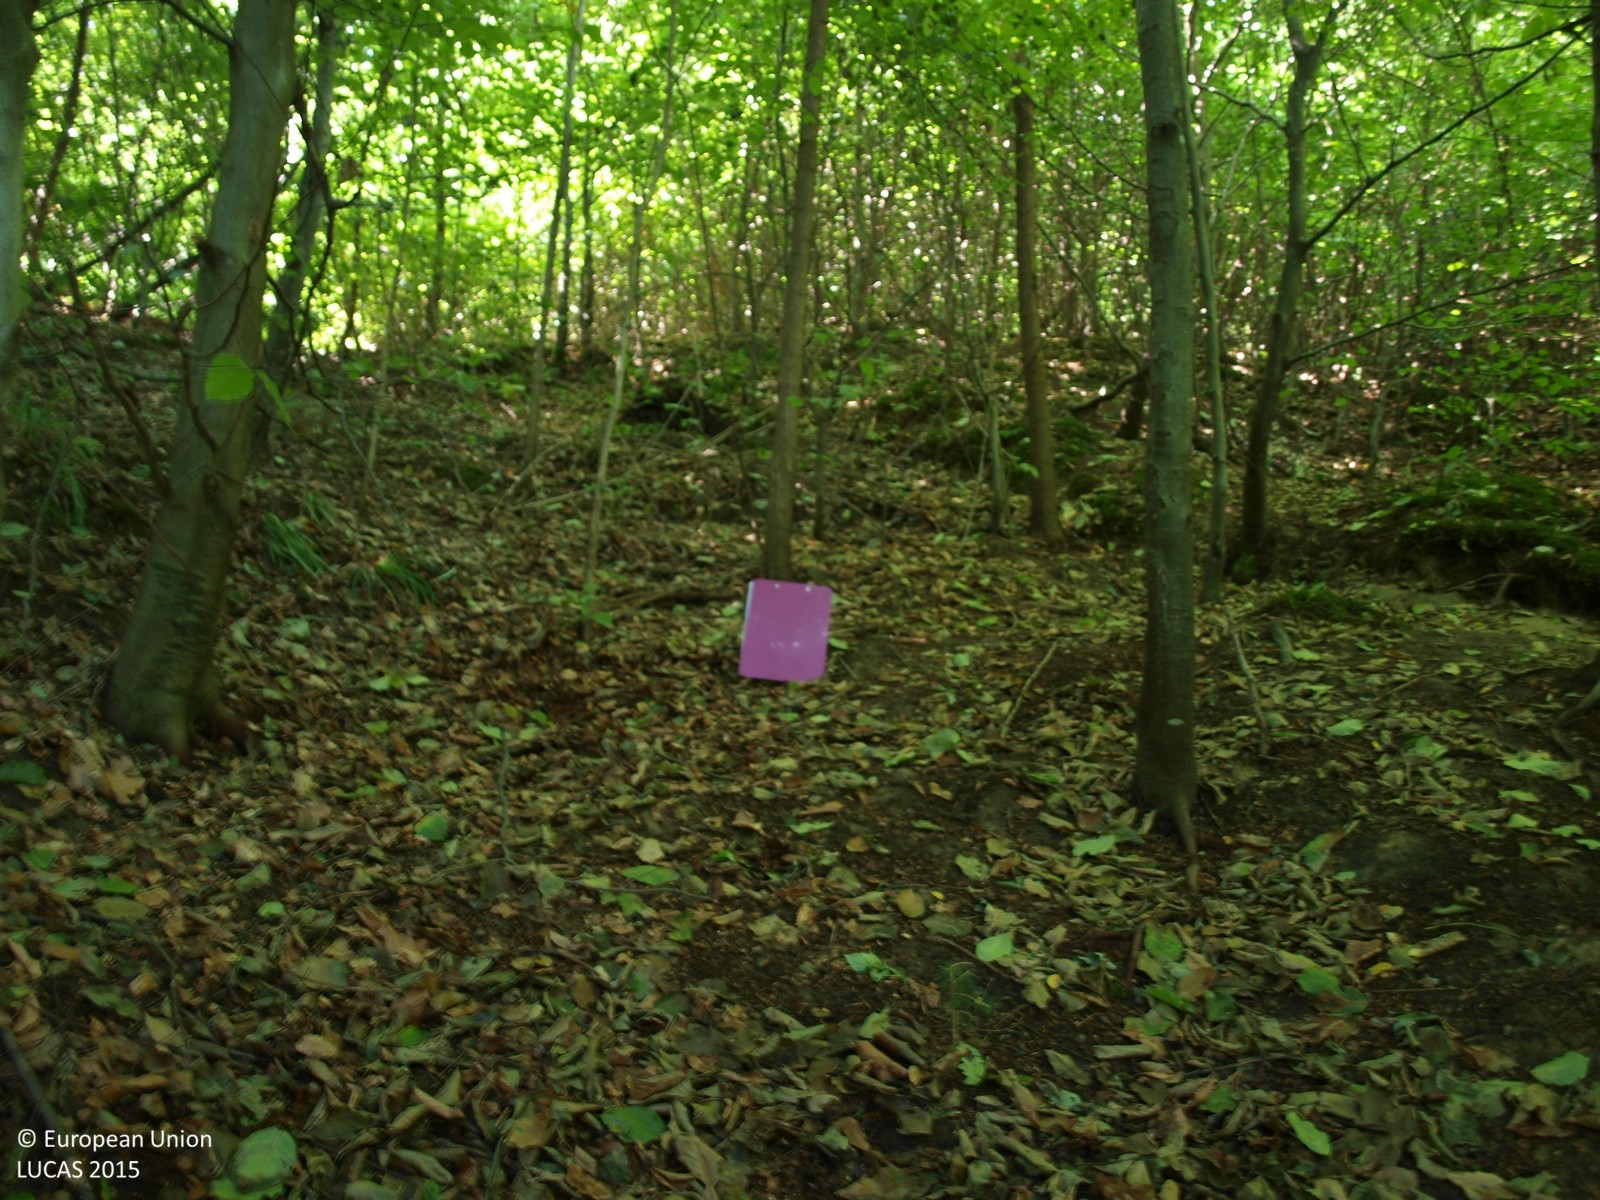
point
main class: Woodland
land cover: Broadleaved woodland
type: beech forest
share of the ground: > 75 %
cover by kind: broadleaved forest trees 100 %
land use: Forestry
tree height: > 5 m
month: August
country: HR
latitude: 46.0005
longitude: 16.3393
